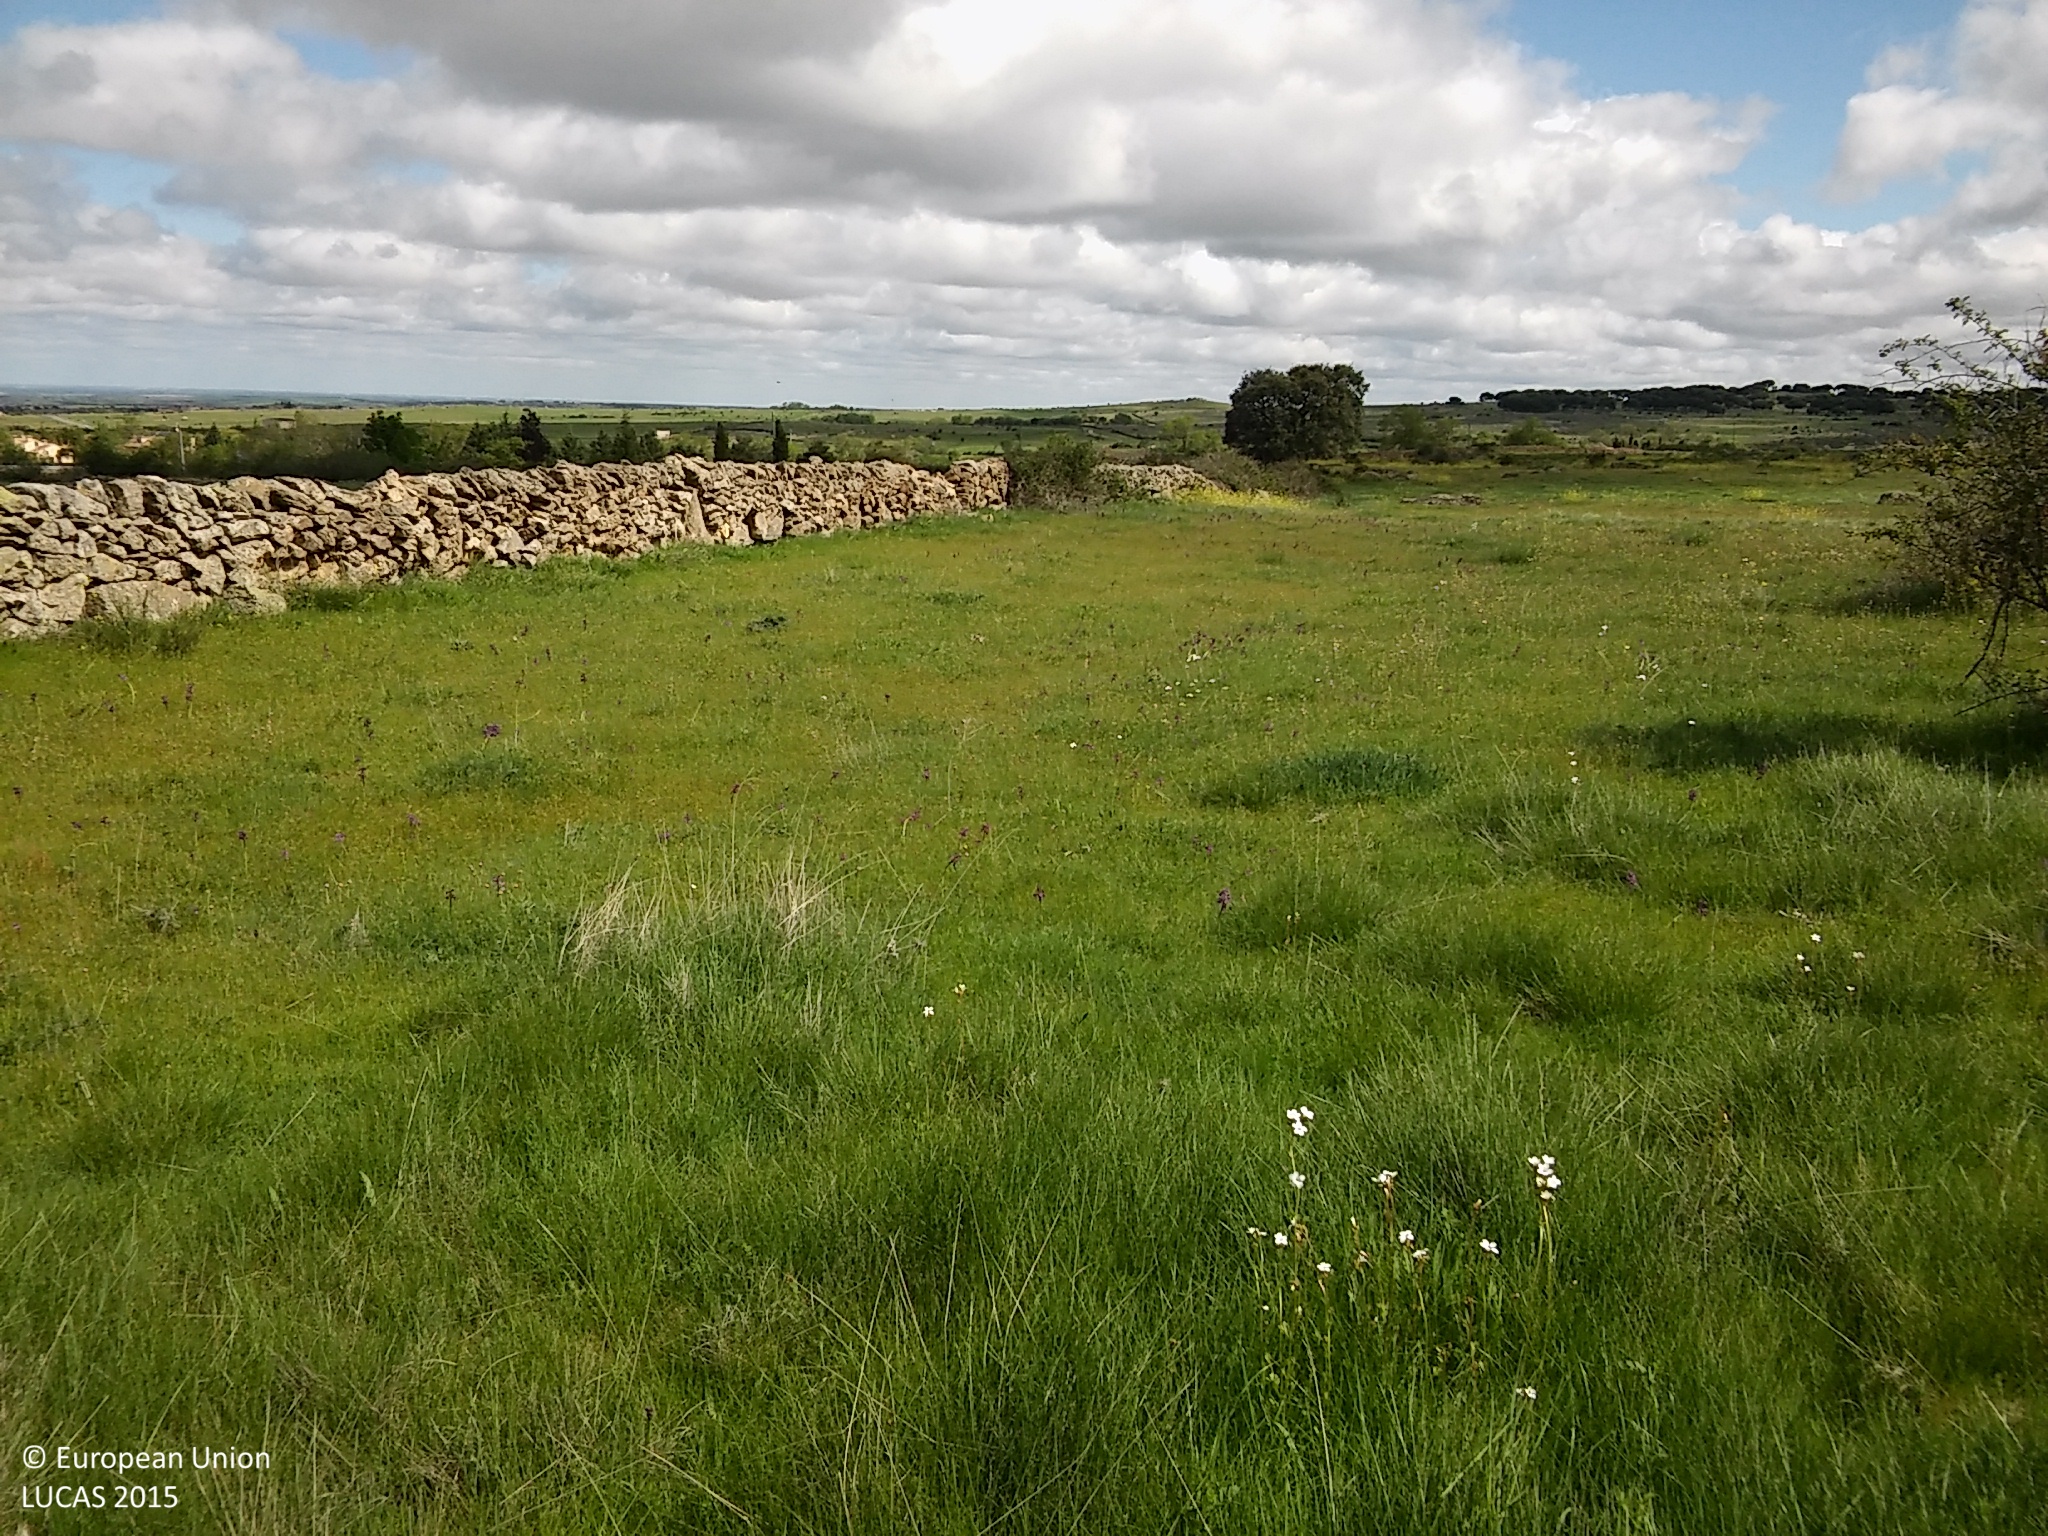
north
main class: Grassland
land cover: Grassland without tree/shrub cover
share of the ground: > 75 %
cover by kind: herbaceous plants 95 %, shrubs 5 %
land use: Agriculture (excluding fallow land and kitchen gardens)
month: May
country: ES
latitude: 40.9963
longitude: -4.0176
